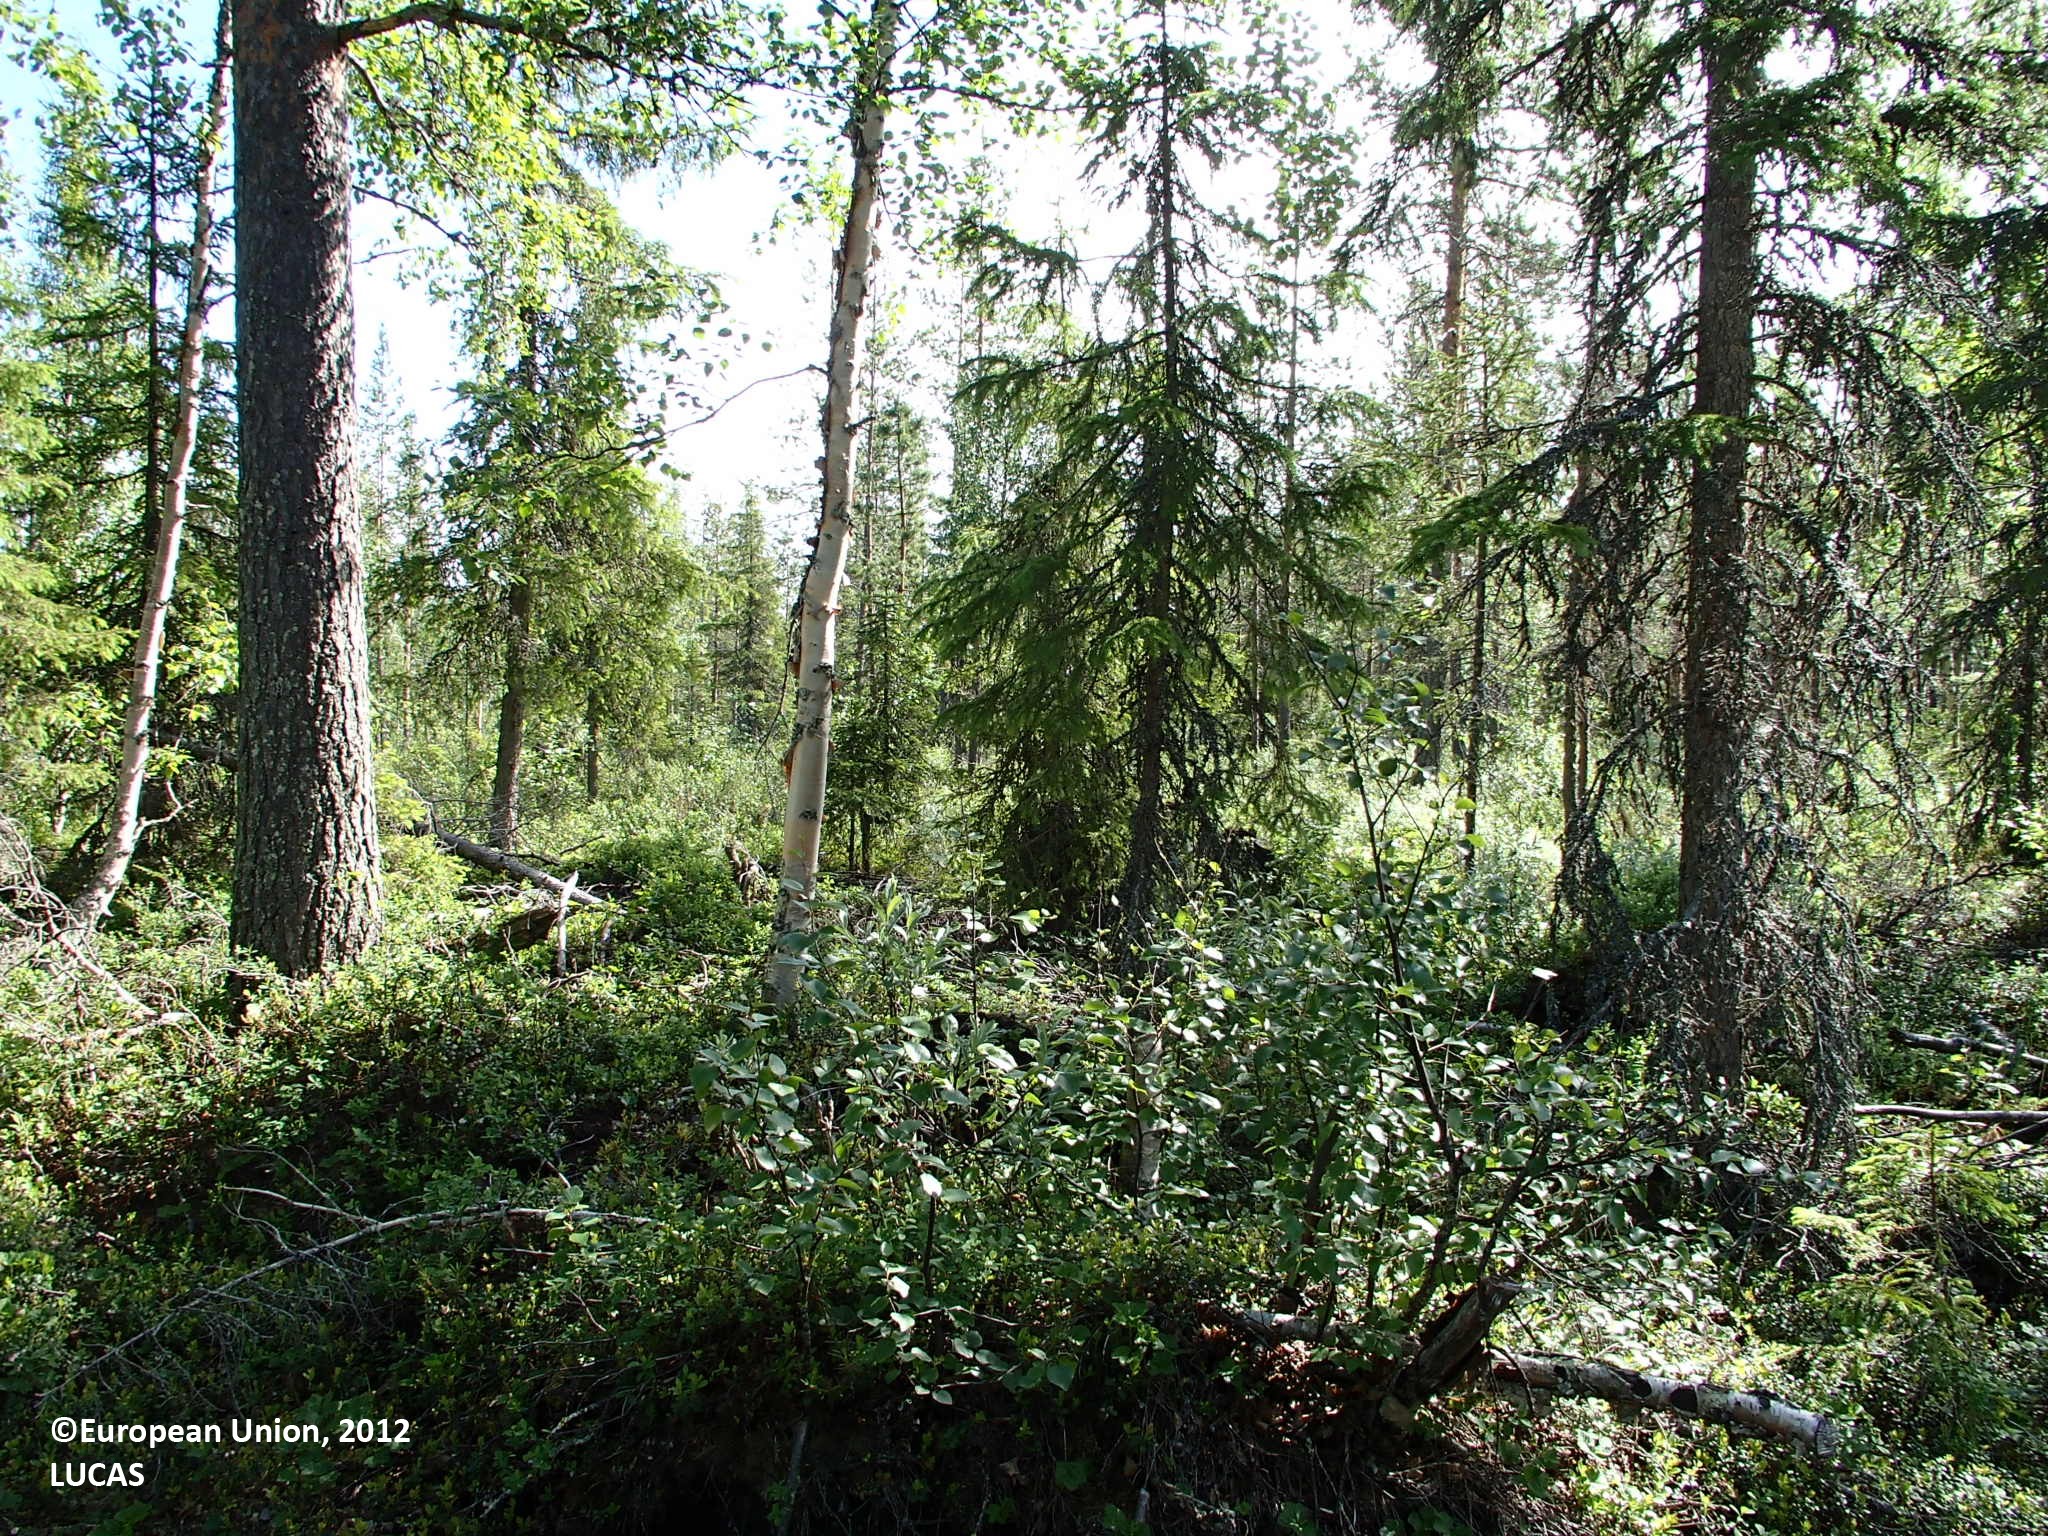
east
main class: Woodland
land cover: Broadleaved woodland
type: boreal forest
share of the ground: 50 - 75 %
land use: Forestry
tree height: > 5 m
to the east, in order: Broadleaved woodland; Ditches and canals; Other mixed woodland; Broadleaved woodland; Peatbogs; Ditches and canals; Peatbogs; Other mixed woodland; Ditches and canals; Other mixed woodland; Ditches and canals; Other mixed woodland; Ditches and canals; Other mixed woodland; Rivers and streams; Other mixed woodland
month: July
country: FI
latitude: 67.3847
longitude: 26.1680
